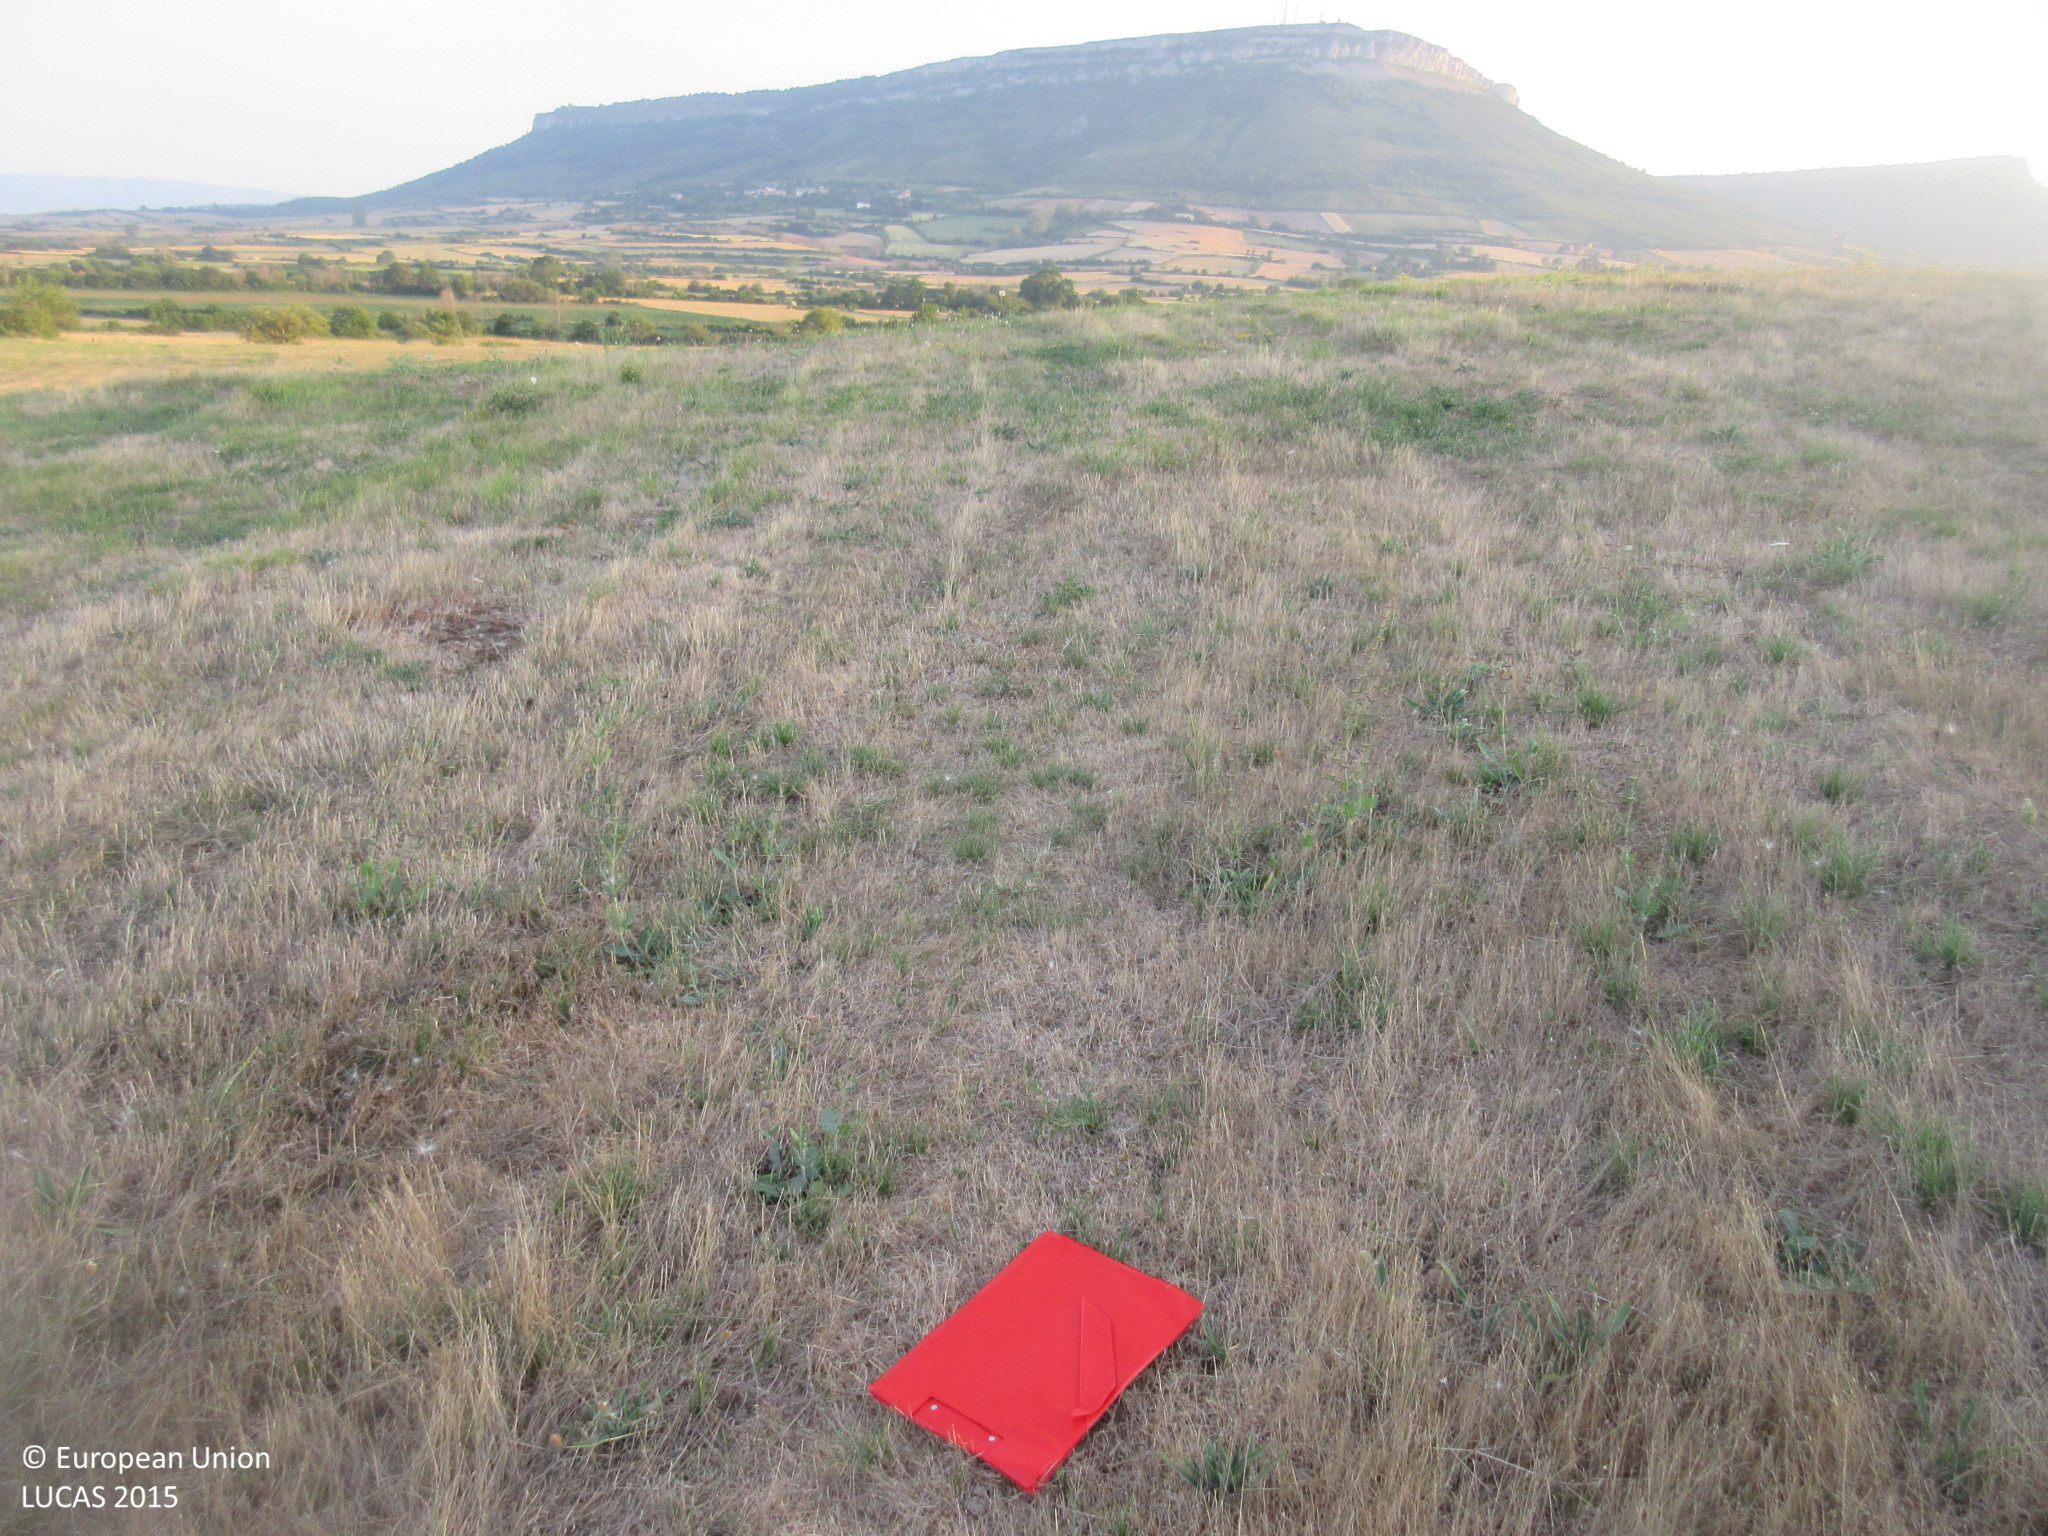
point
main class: Grassland
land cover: Grassland without tree/shrub cover
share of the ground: > 75 %
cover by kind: herbaceous plants 100 %
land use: Agriculture (excluding fallow land and kitchen gardens)
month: July
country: ES
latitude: 43.0604
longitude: -3.5104
